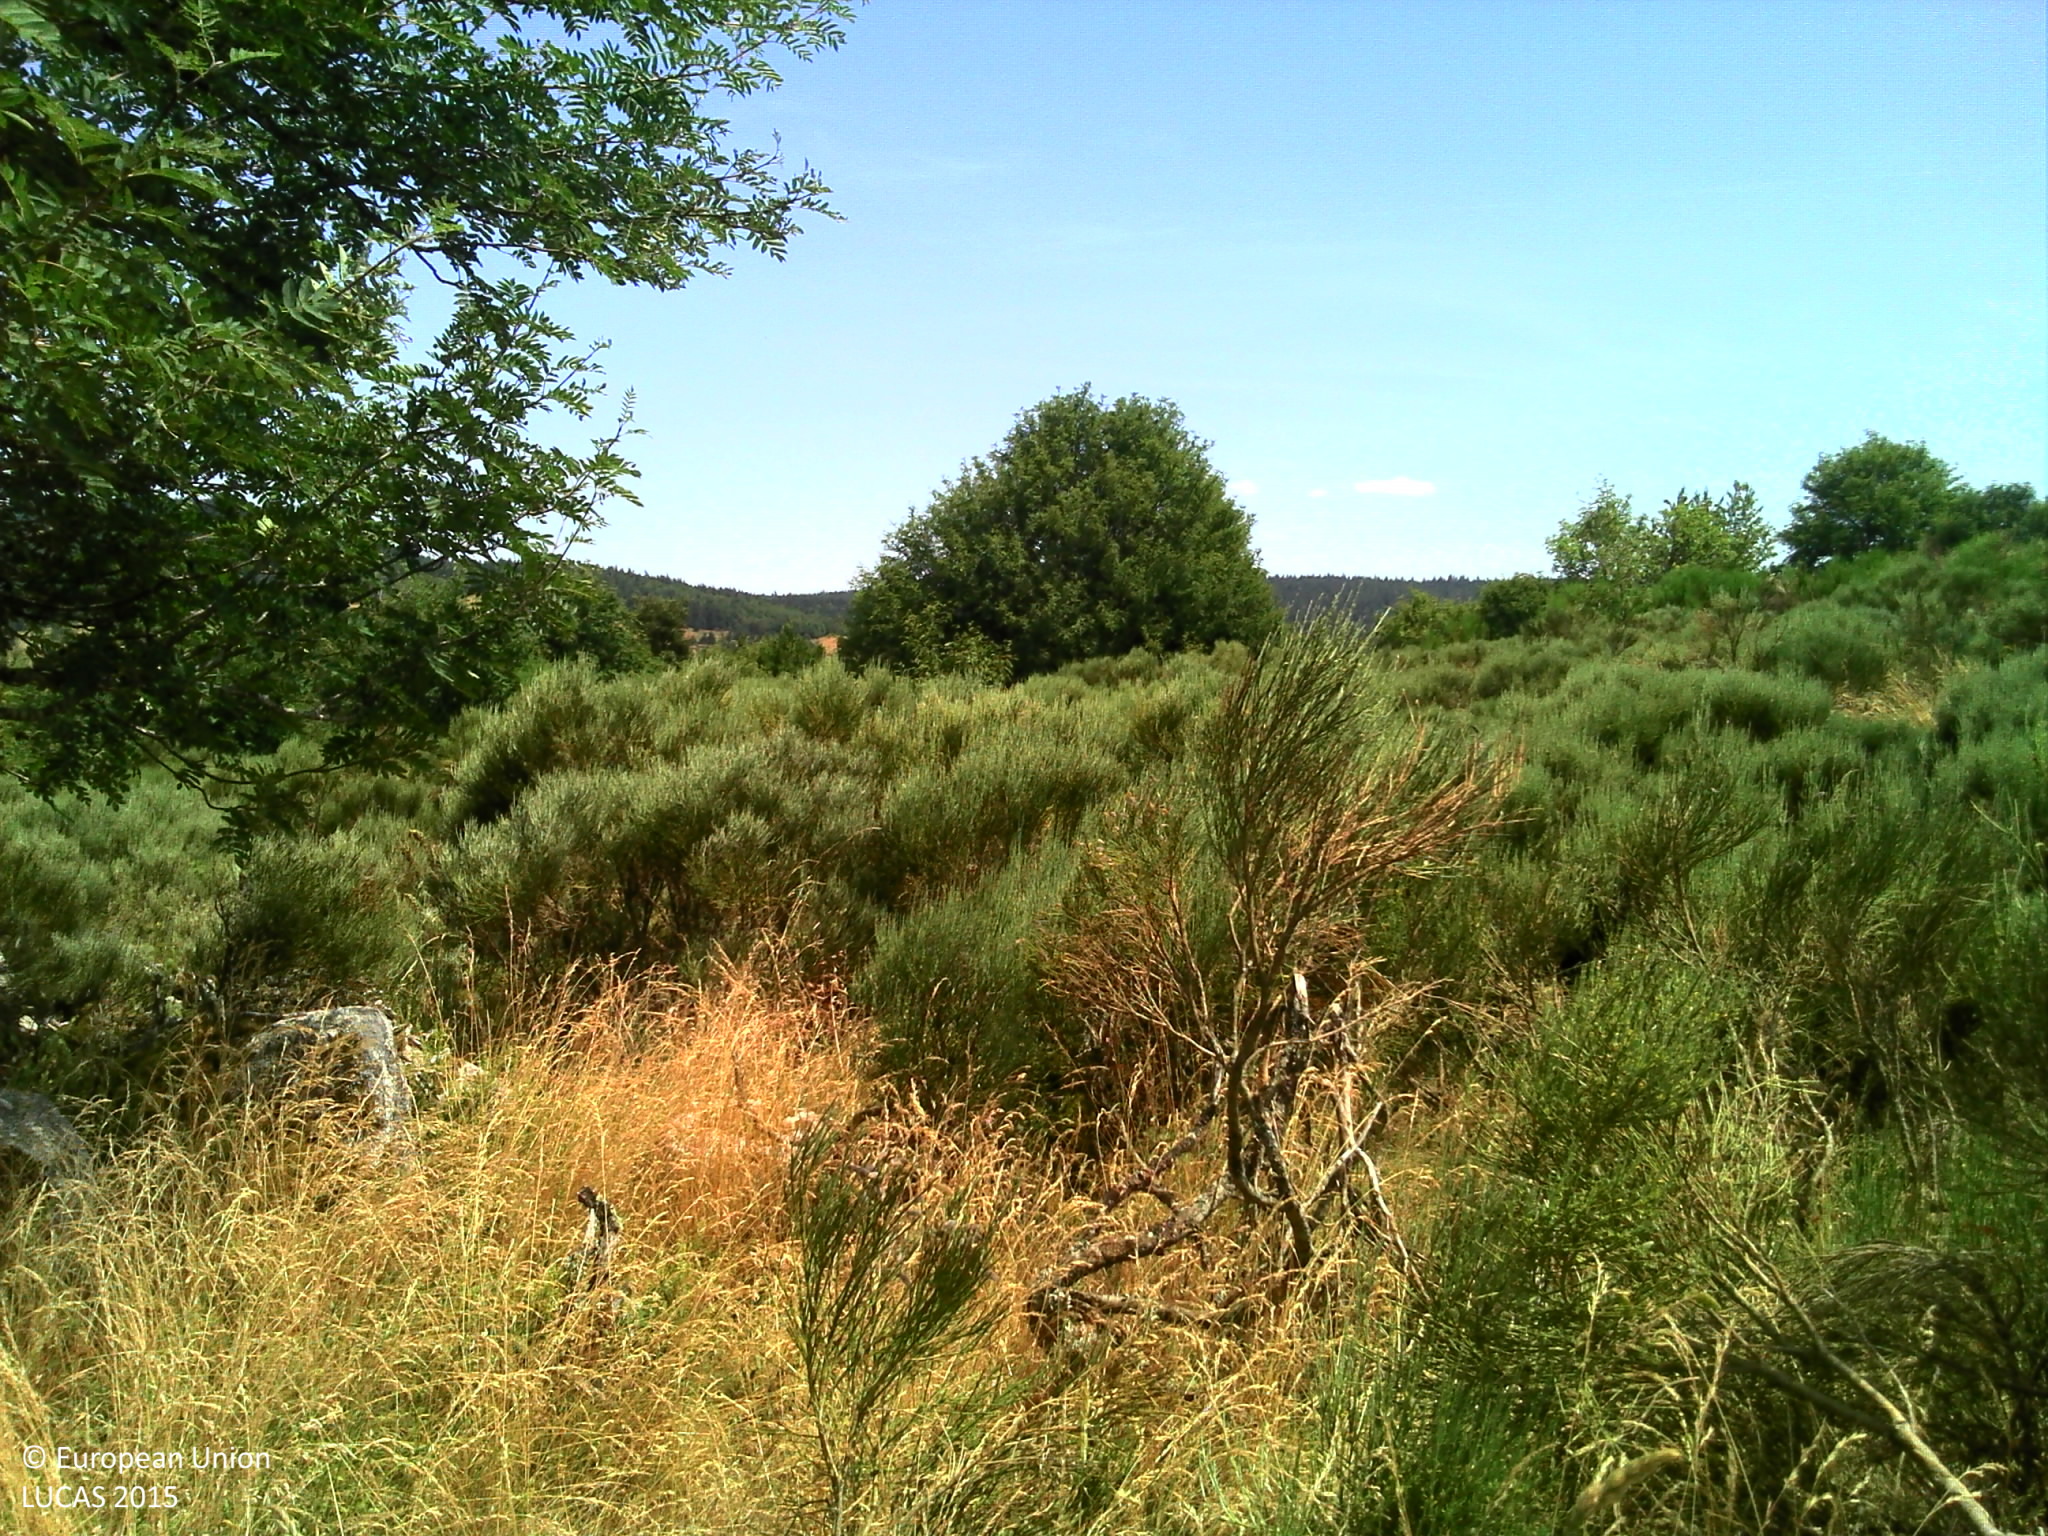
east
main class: Cropland
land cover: Oats
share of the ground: > 75 %
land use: Agriculture (excluding fallow land and kitchen gardens)
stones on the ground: < 10 %
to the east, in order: Oats; Shrubland with sparse tree cover; Grassland without tree/shrub cover; Shrubland with sparse tree cover; Tracks; Fences; Shrubland with sparse tree cover; Other mixed woodland
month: July
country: FR
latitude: 44.8692
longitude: 3.4855
